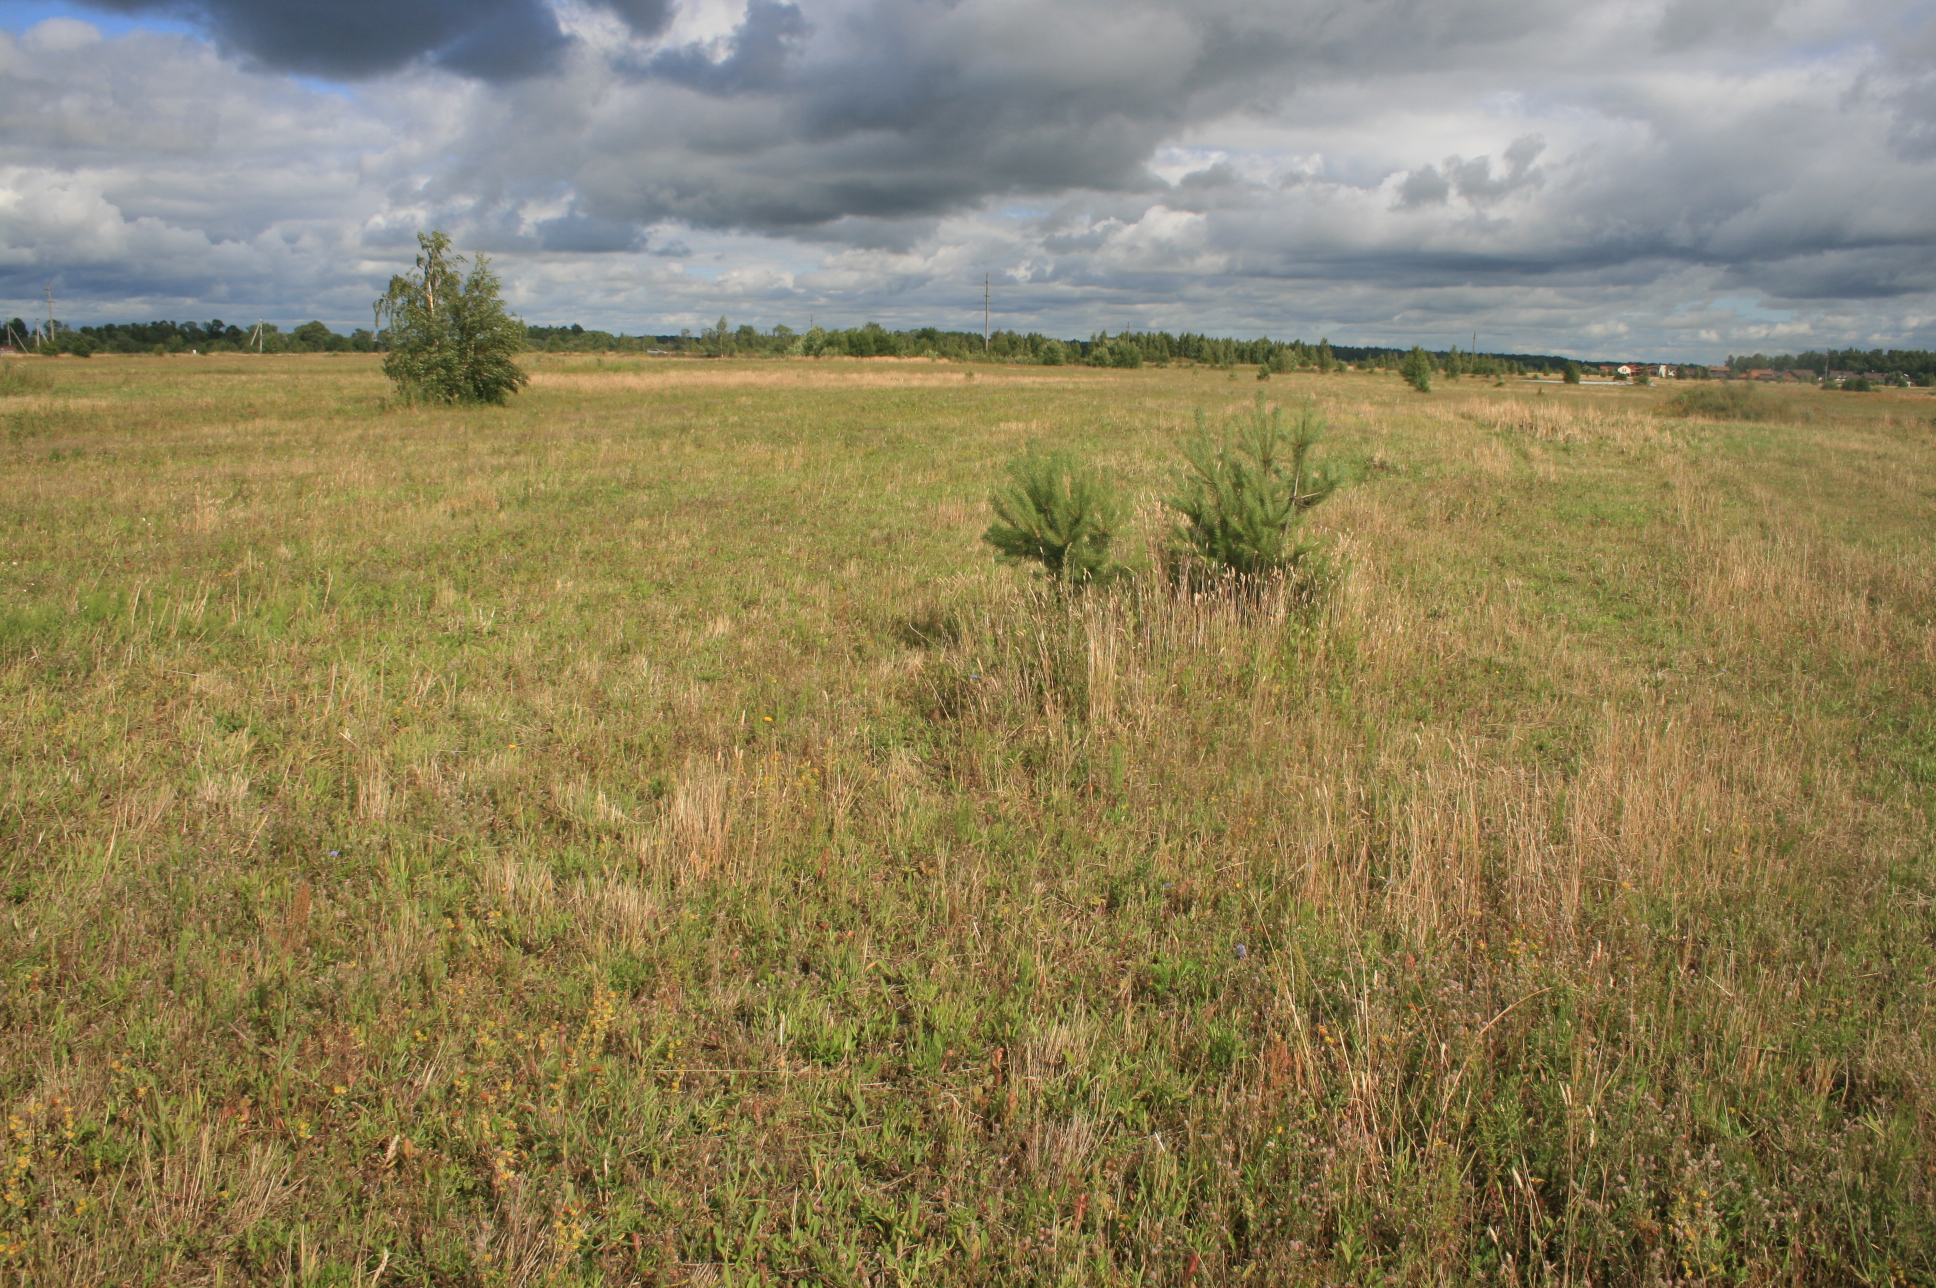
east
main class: Grassland
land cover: Grassland without tree/shrub cover
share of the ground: > 75 %
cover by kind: herbaceous plants 100 %
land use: Agriculture (excluding fallow land and kitchen gardens)
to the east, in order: Grassland without tree/shrub cover; Grassland with sparse tree/shrub cover; Grassland without tree/shrub cover; Spontaneously vegetated surfaces; Ditches and canals; Spontaneously vegetated surfaces; Grassland without tree/shrub cover
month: July
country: LT
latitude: 55.7877
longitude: 21.1878
